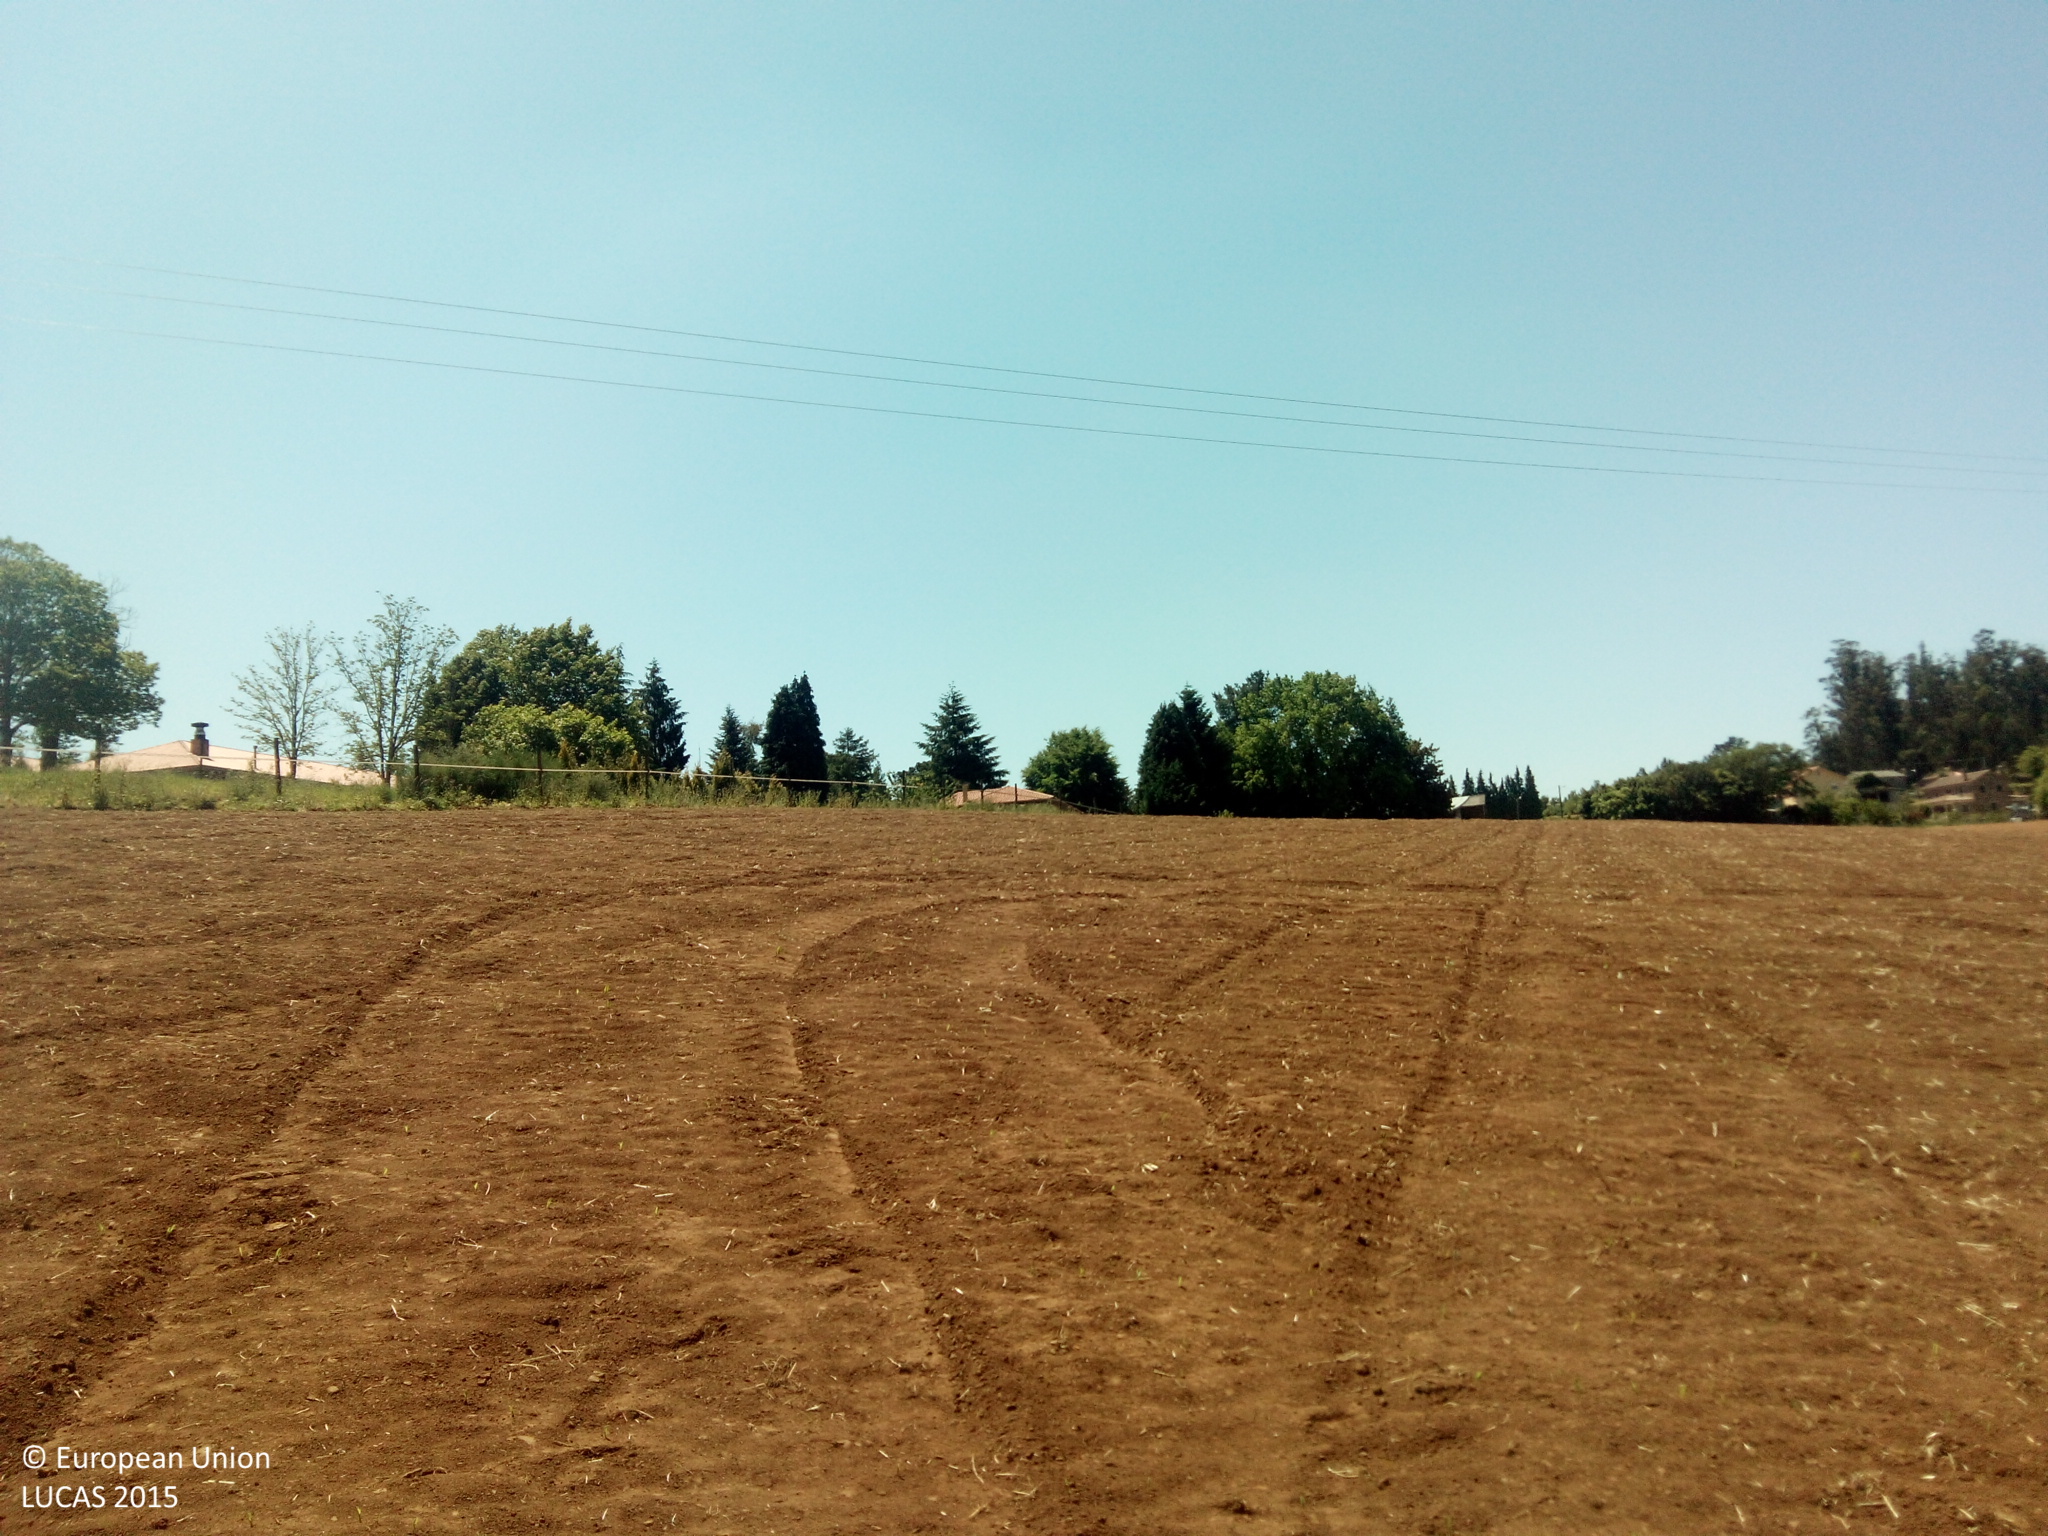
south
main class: Cropland
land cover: Maize
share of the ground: < 10 %
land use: Agriculture (excluding fallow land and kitchen gardens)
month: May
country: ES
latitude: 42.8239
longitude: -8.4615
